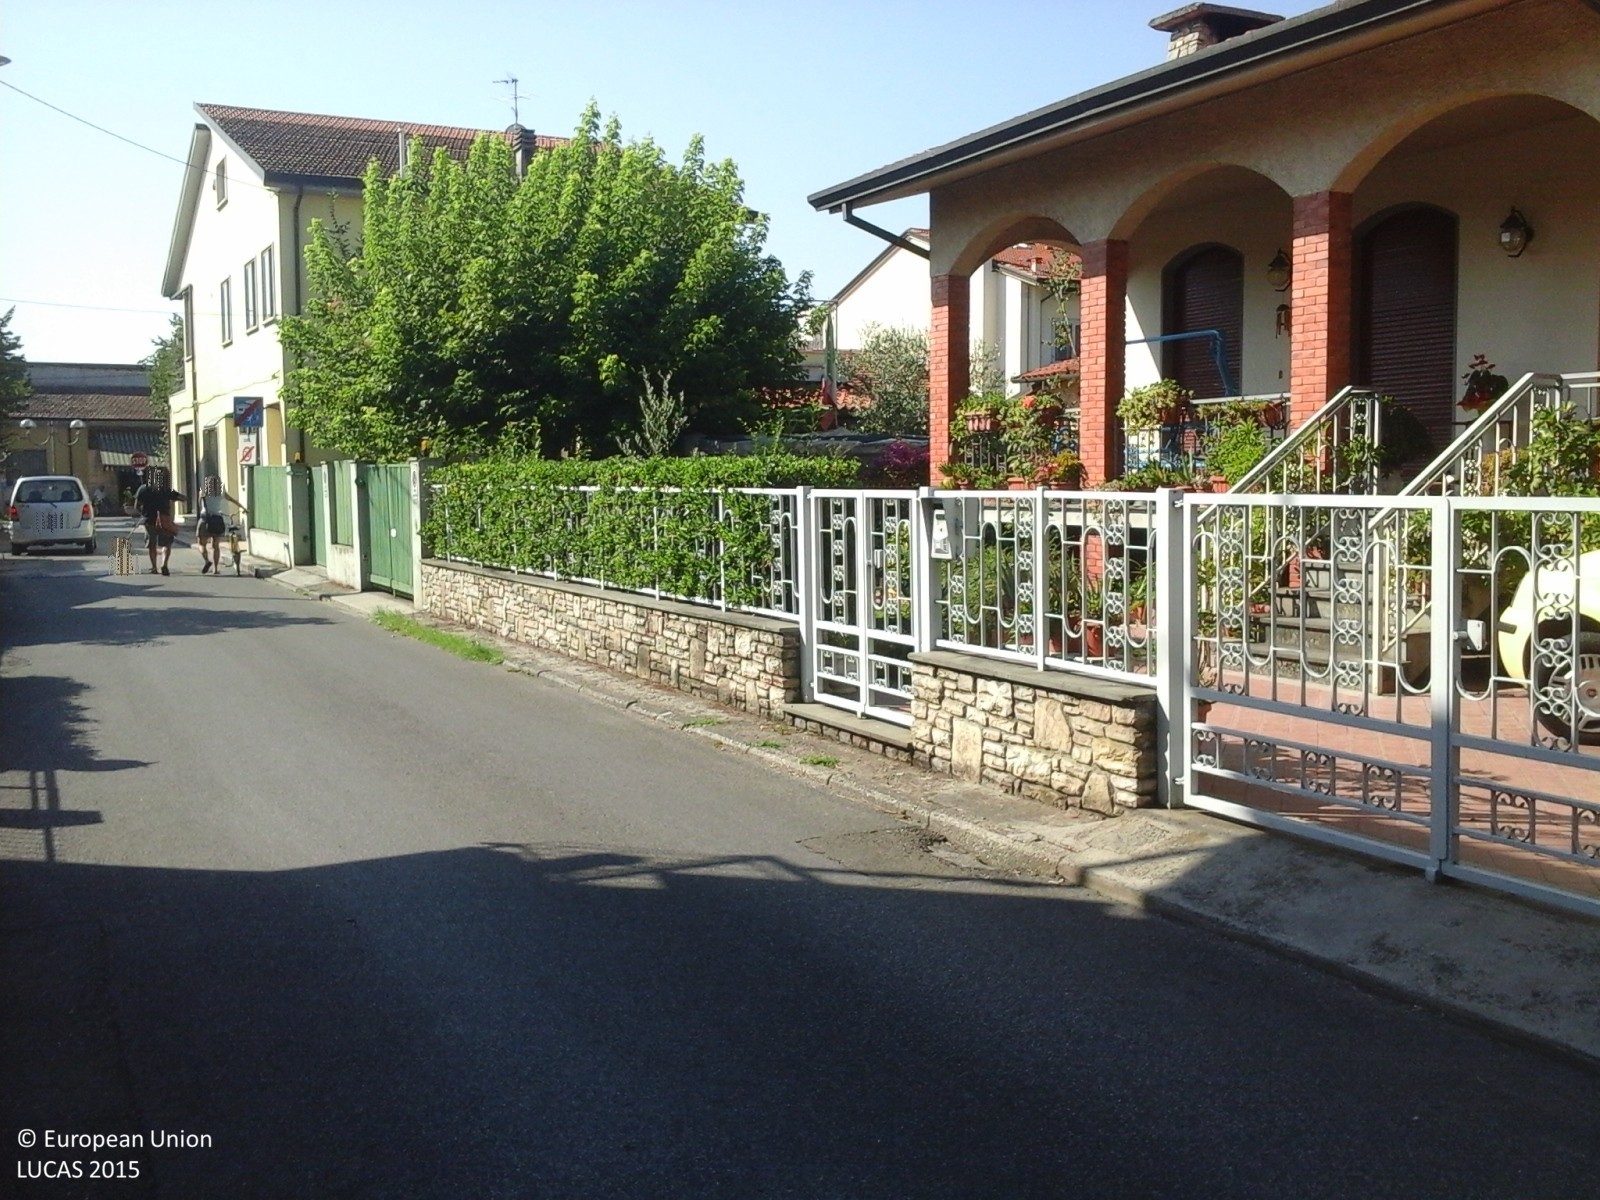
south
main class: Woodland
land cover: Broadleaved woodland
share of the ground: > 75 %
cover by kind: broadleaved forest trees 50 %, herbaceous plants 40 %, shrubs 10 %
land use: Community services
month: August
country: IT
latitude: 43.8270
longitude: 10.2852
